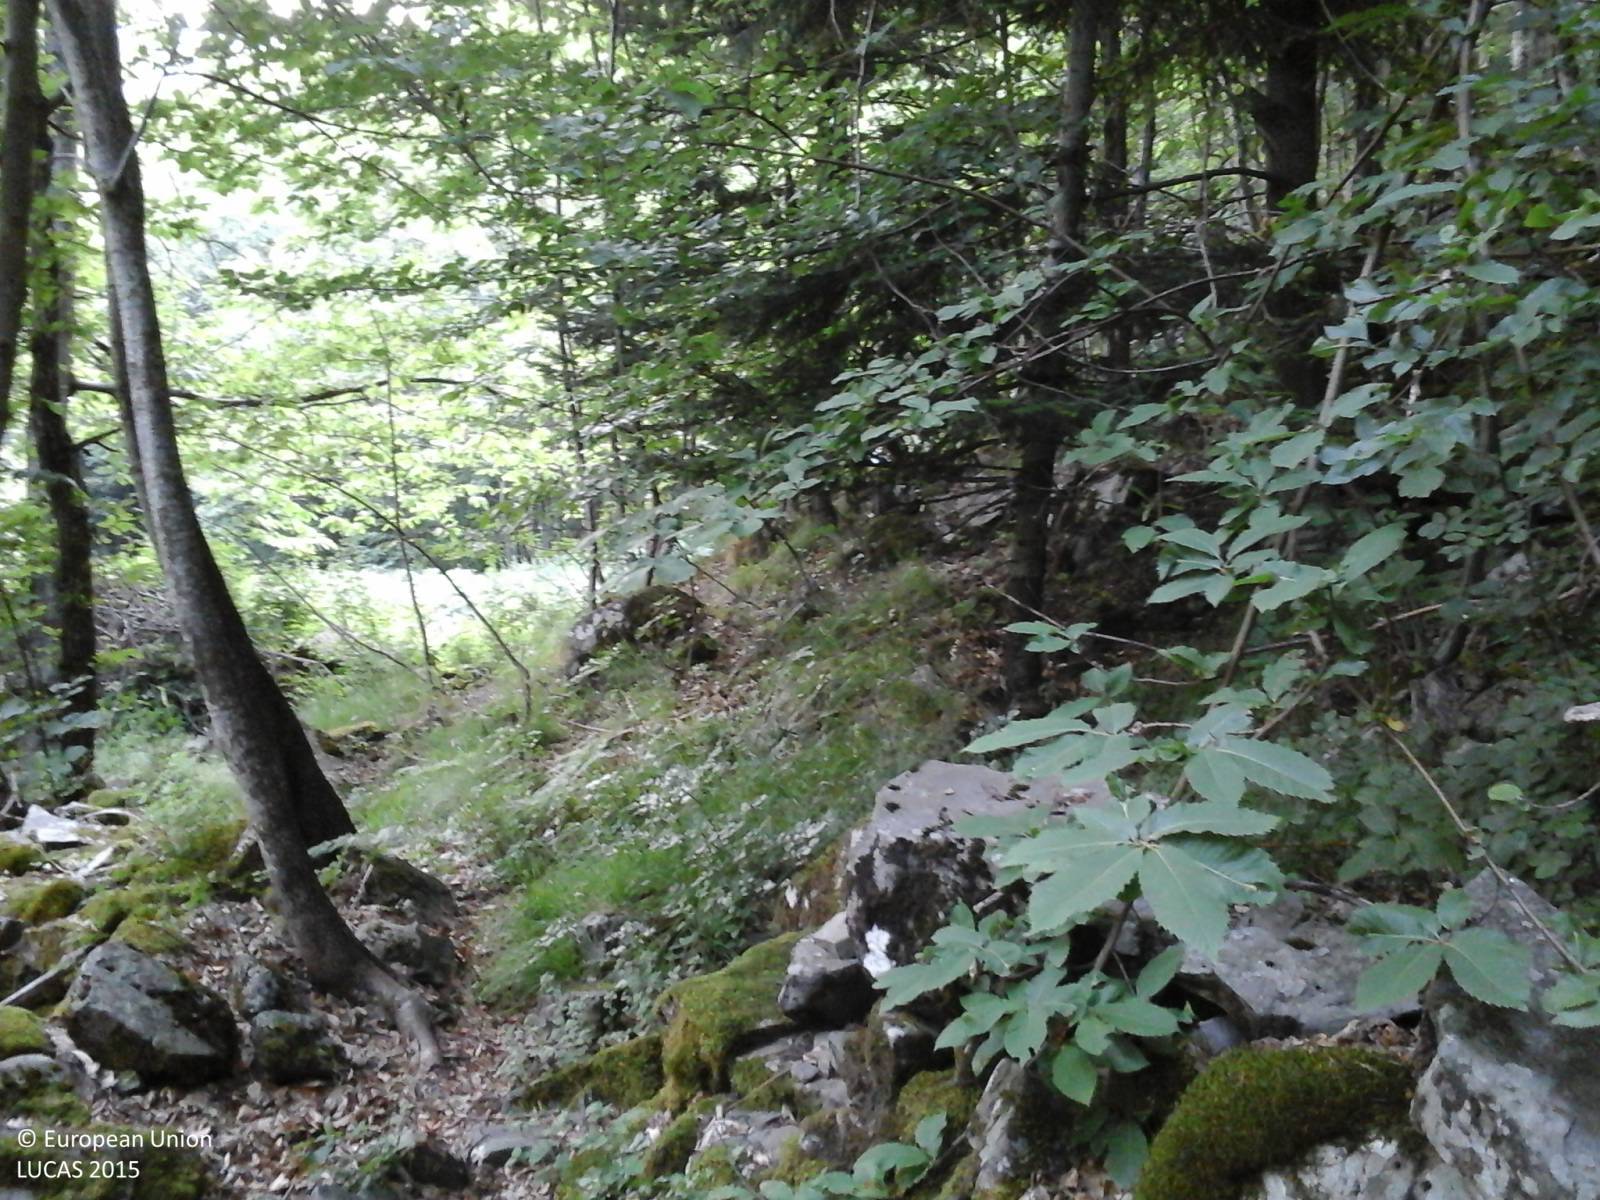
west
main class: Woodland
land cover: Broadleaved woodland
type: thermophilous deciduous forest
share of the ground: > 75 %
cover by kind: broadleaved forest trees 75 %, shrubs 25 %
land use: Forestry
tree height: > 5 m
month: June
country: IT
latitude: 44.1317
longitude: 10.7107
